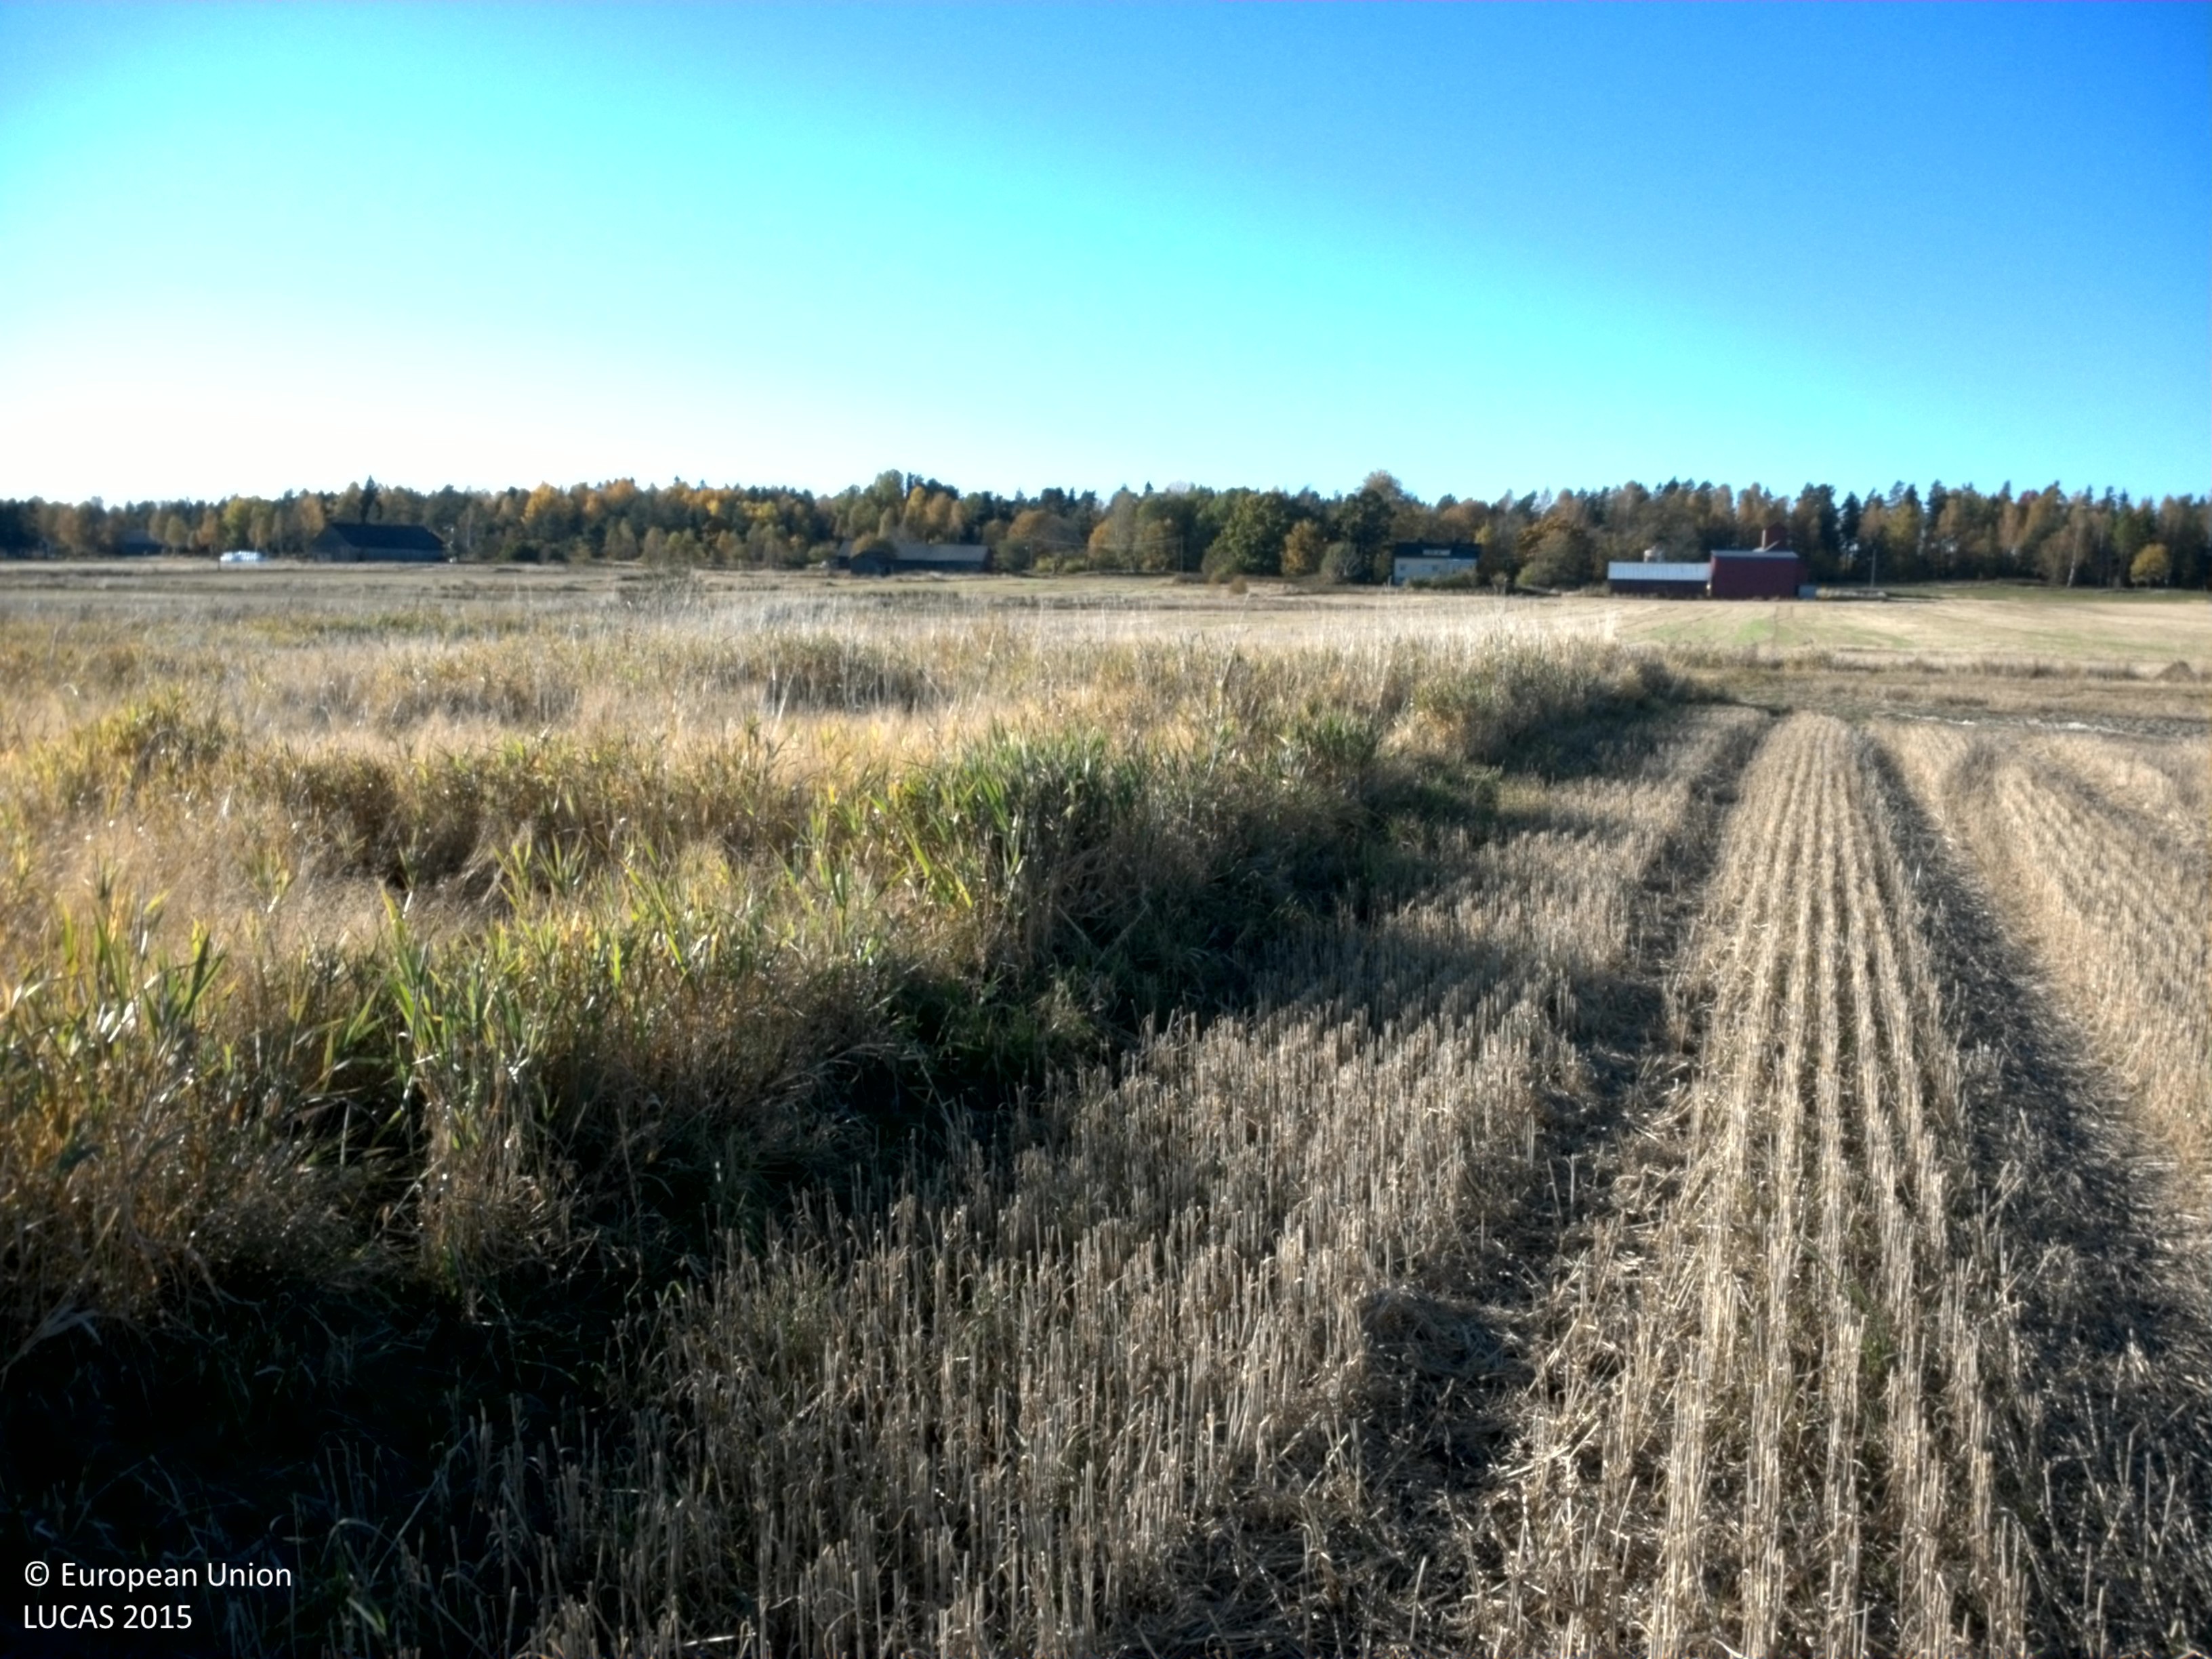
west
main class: Cropland
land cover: Common wheat
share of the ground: > 75 %
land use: Agriculture (excluding fallow land and kitchen gardens)
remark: Harvested field
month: October
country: SE
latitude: 59.0656
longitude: 13.1151
